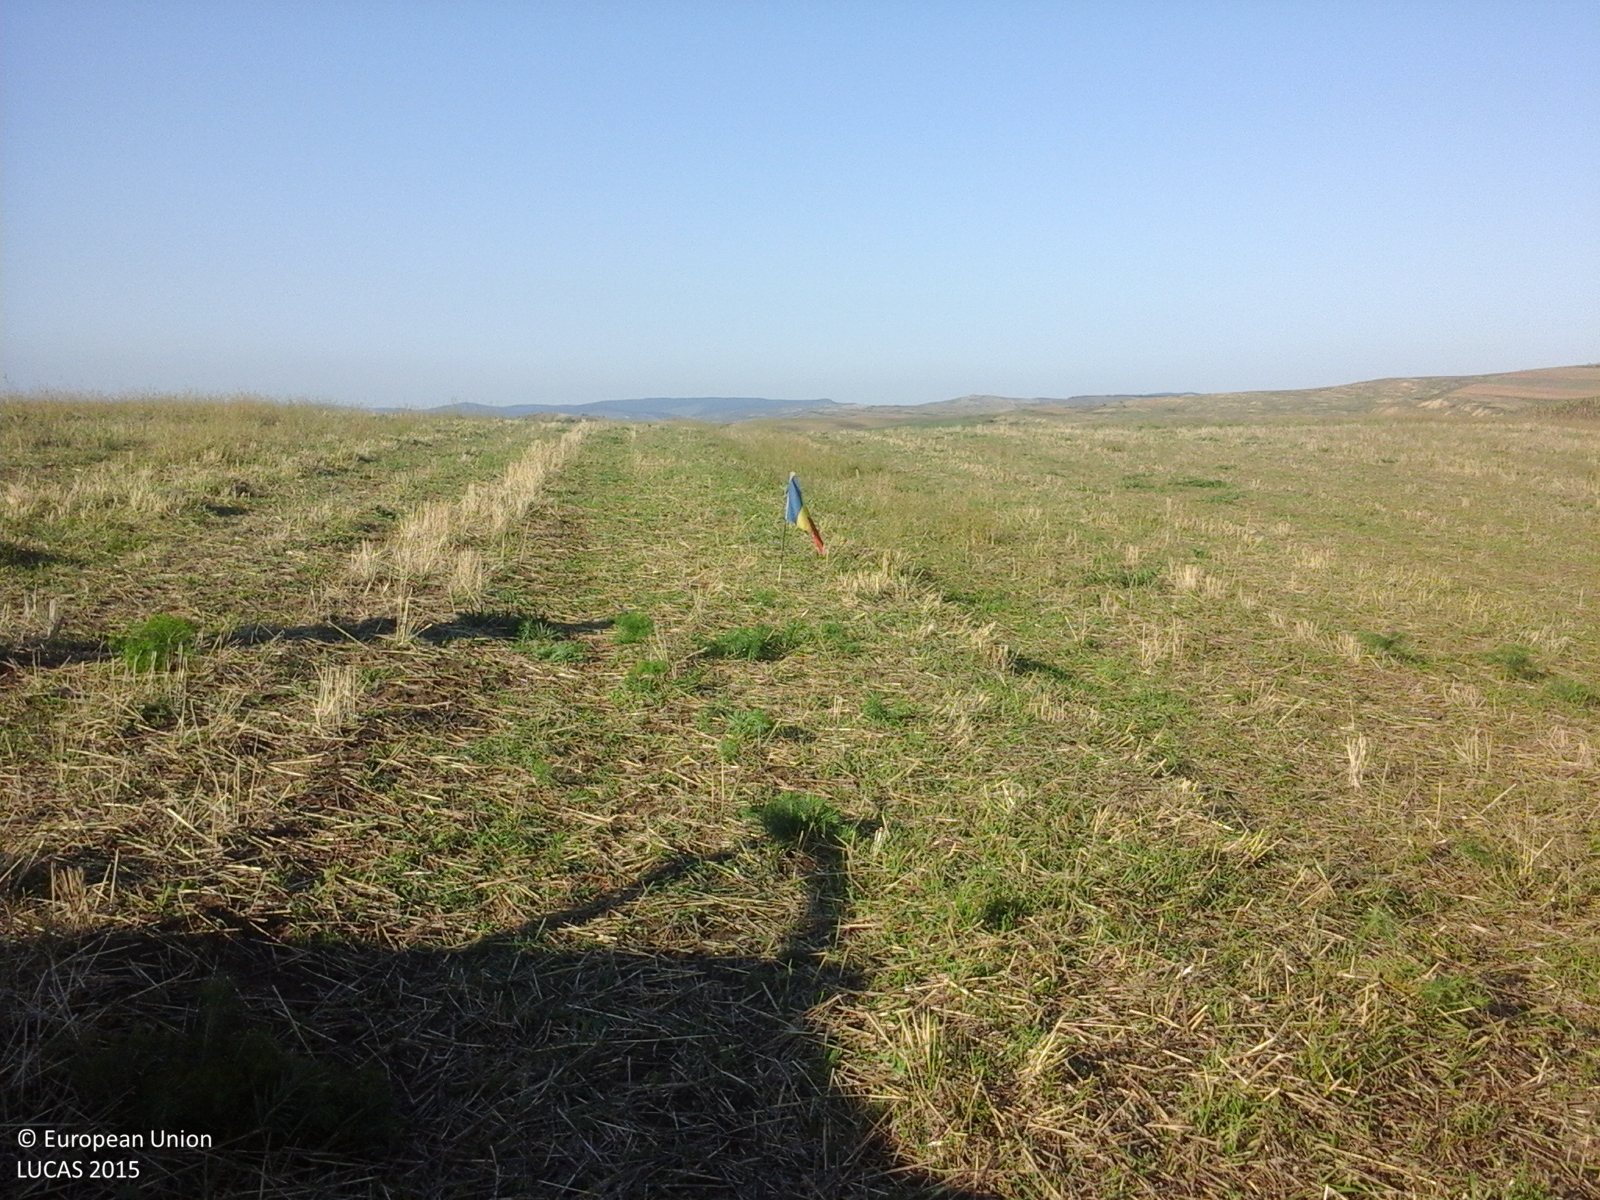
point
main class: Grassland
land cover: Grassland without tree/shrub cover
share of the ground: > 75 %
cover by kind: herbaceous plants 100 %
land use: Agriculture (excluding fallow land and kitchen gardens)
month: October
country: RO
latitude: 46.2075
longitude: 23.7440
